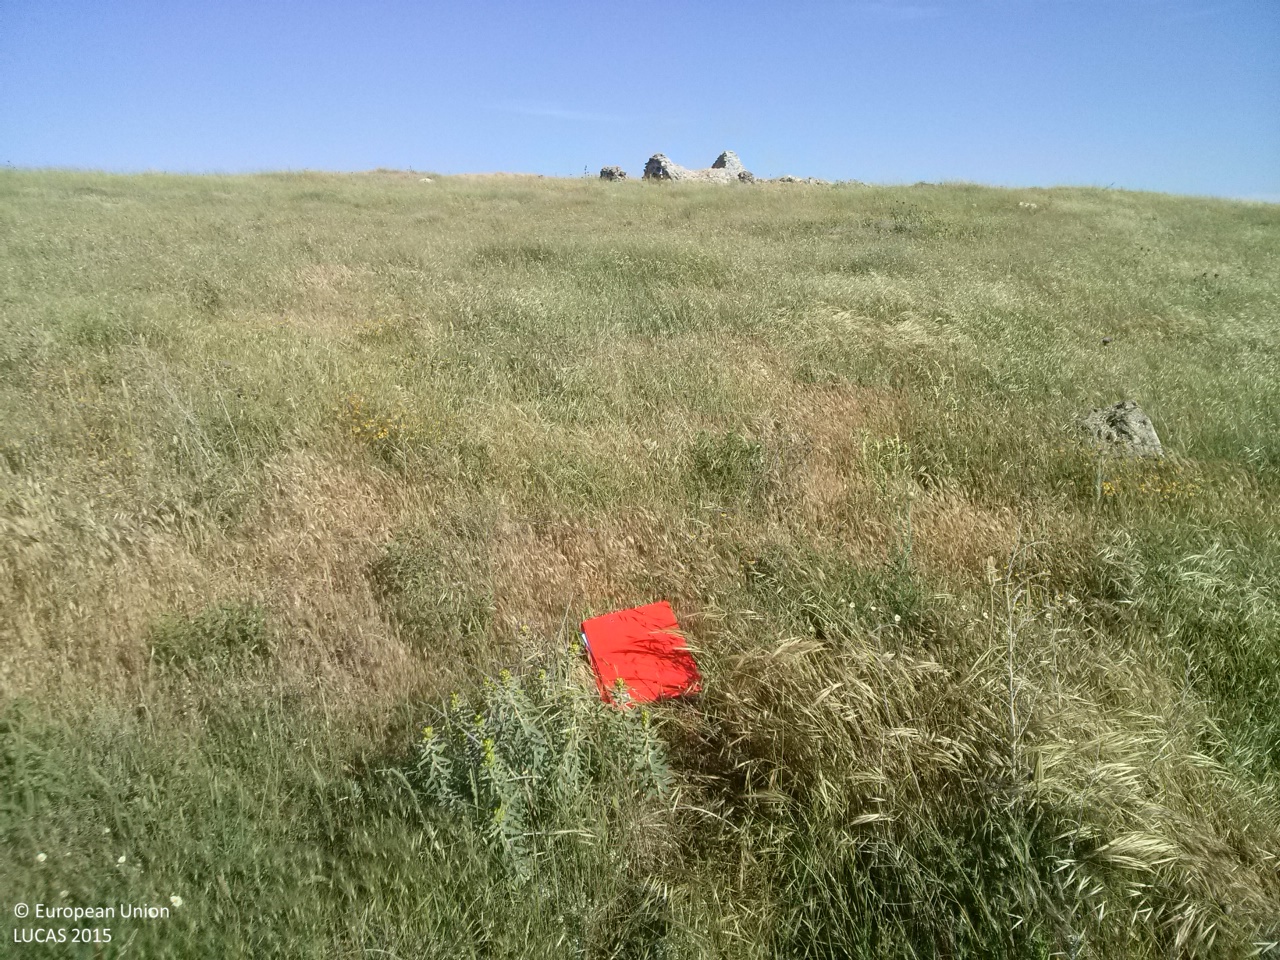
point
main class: Grassland
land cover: Grassland without tree/shrub cover
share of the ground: > 75 %
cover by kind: herbaceous plants 100 %
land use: Abandoned areas
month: May
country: ES
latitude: 40.0519
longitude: -2.7637
